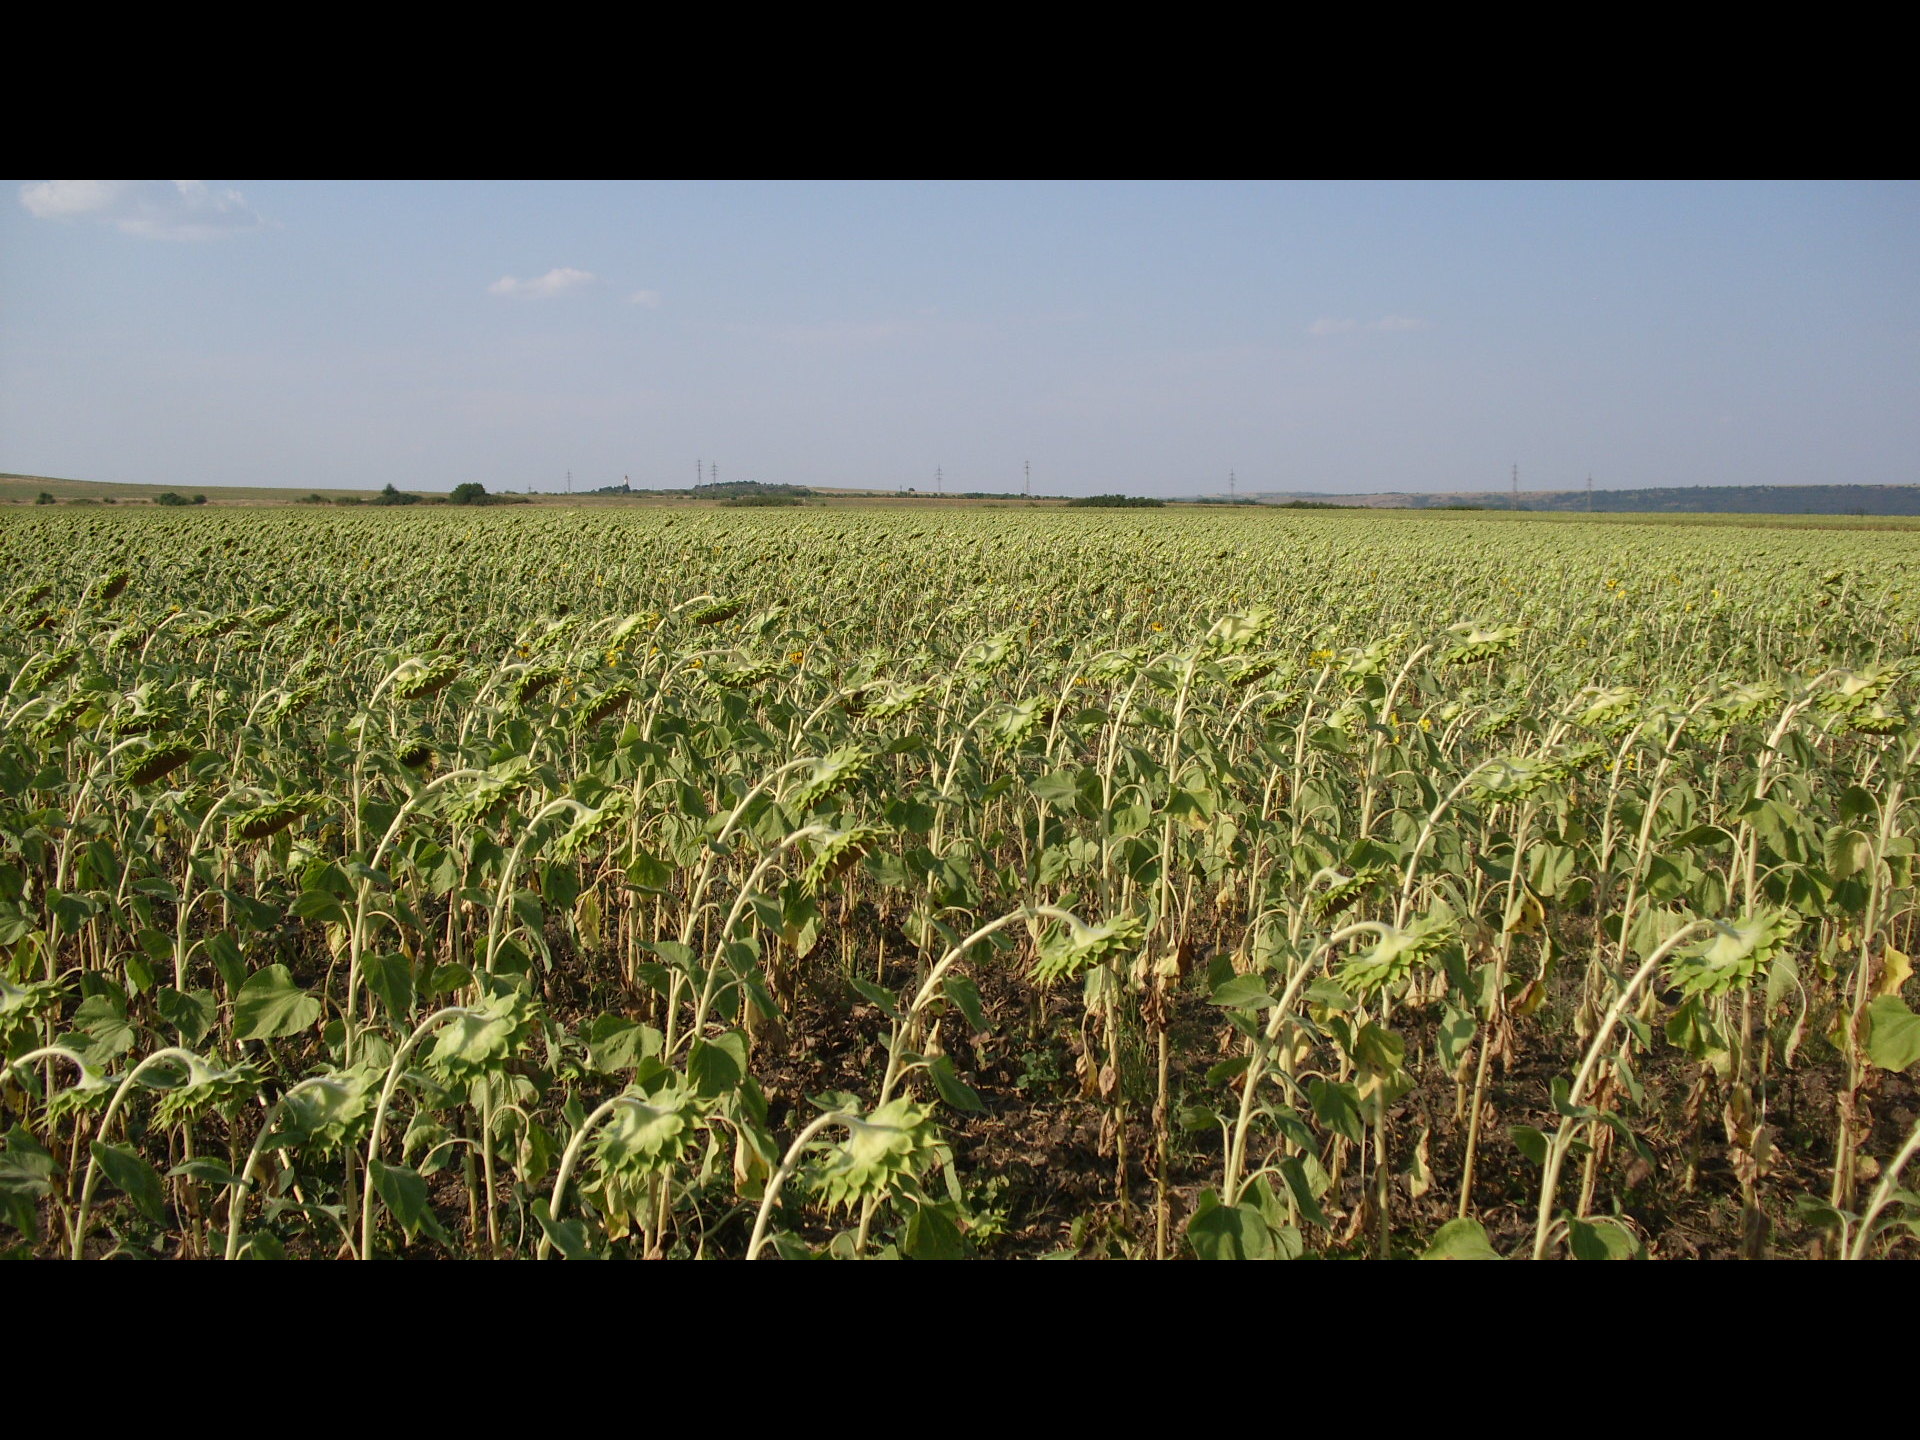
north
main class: Cropland
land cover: Sunflower
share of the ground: > 75 %
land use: Agriculture (excluding fallow land and kitchen gardens)
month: August
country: BG
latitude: 43.3633
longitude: 23.4308
